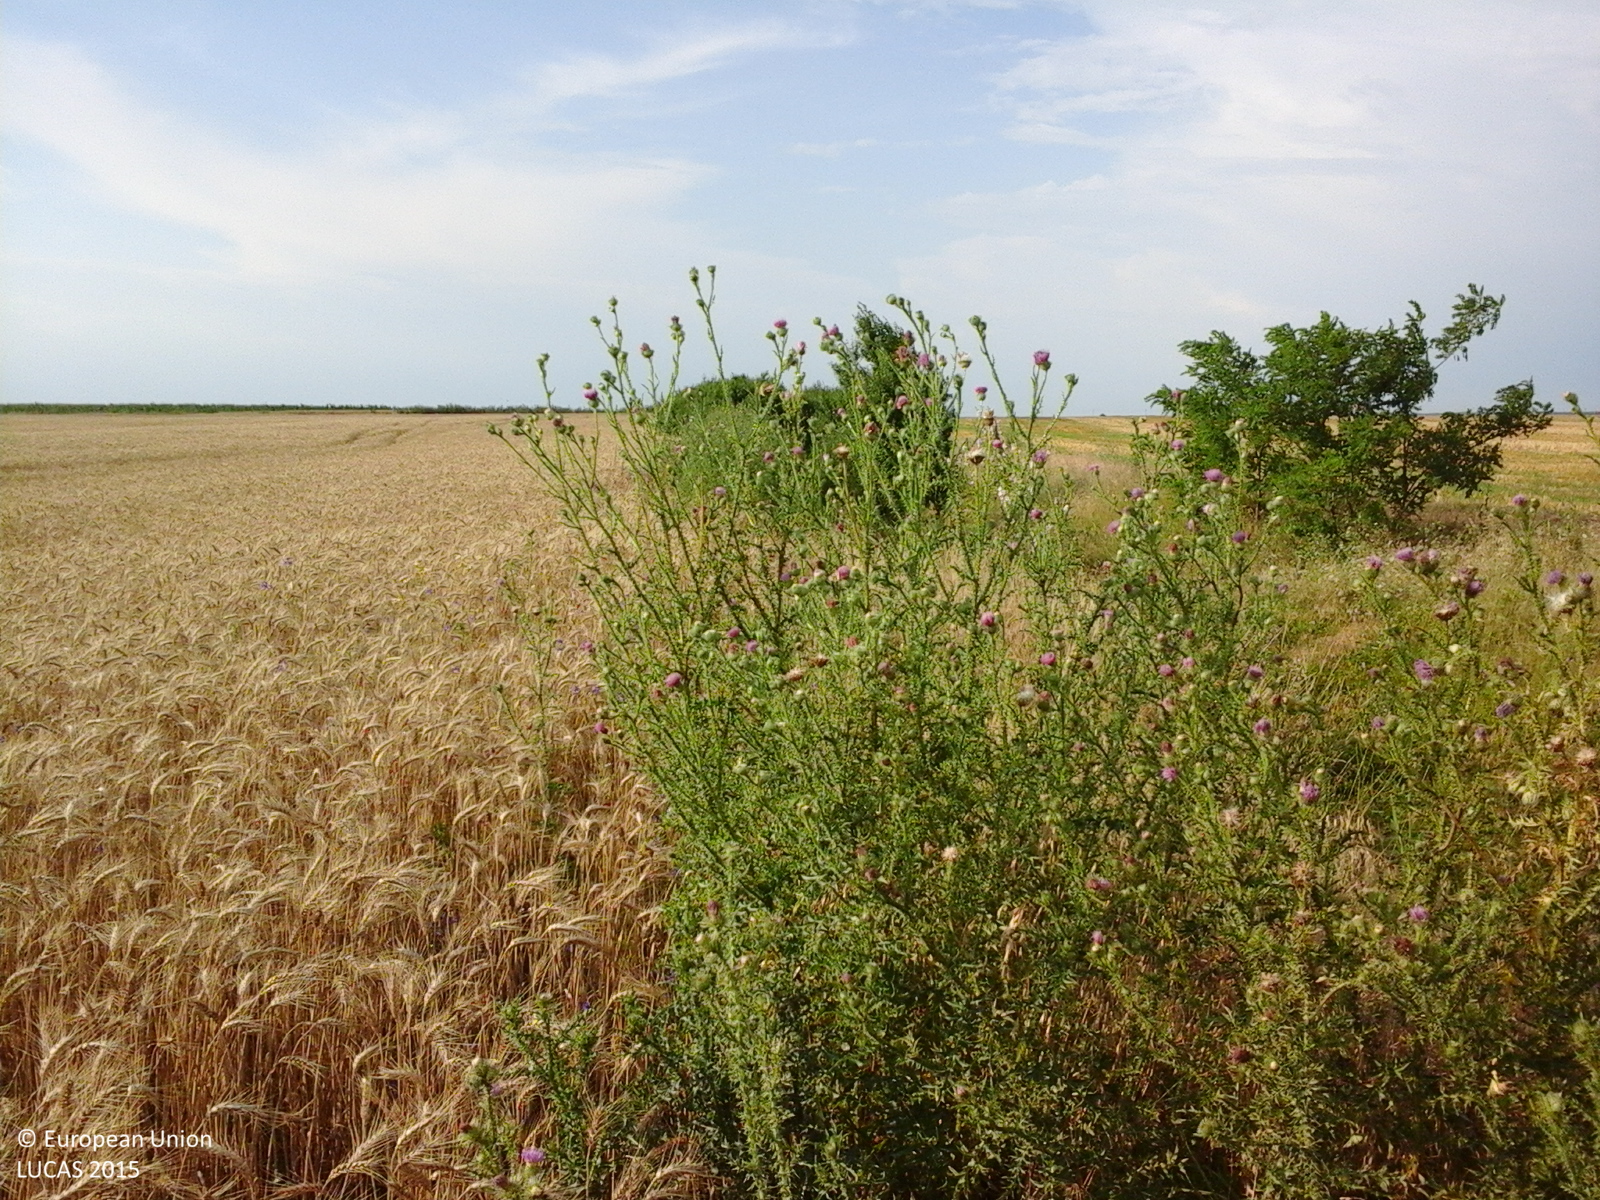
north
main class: Cropland
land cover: Common wheat
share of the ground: > 75 %
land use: Agriculture (excluding fallow land and kitchen gardens)
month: July
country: RO
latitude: 43.9152
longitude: 24.4735
